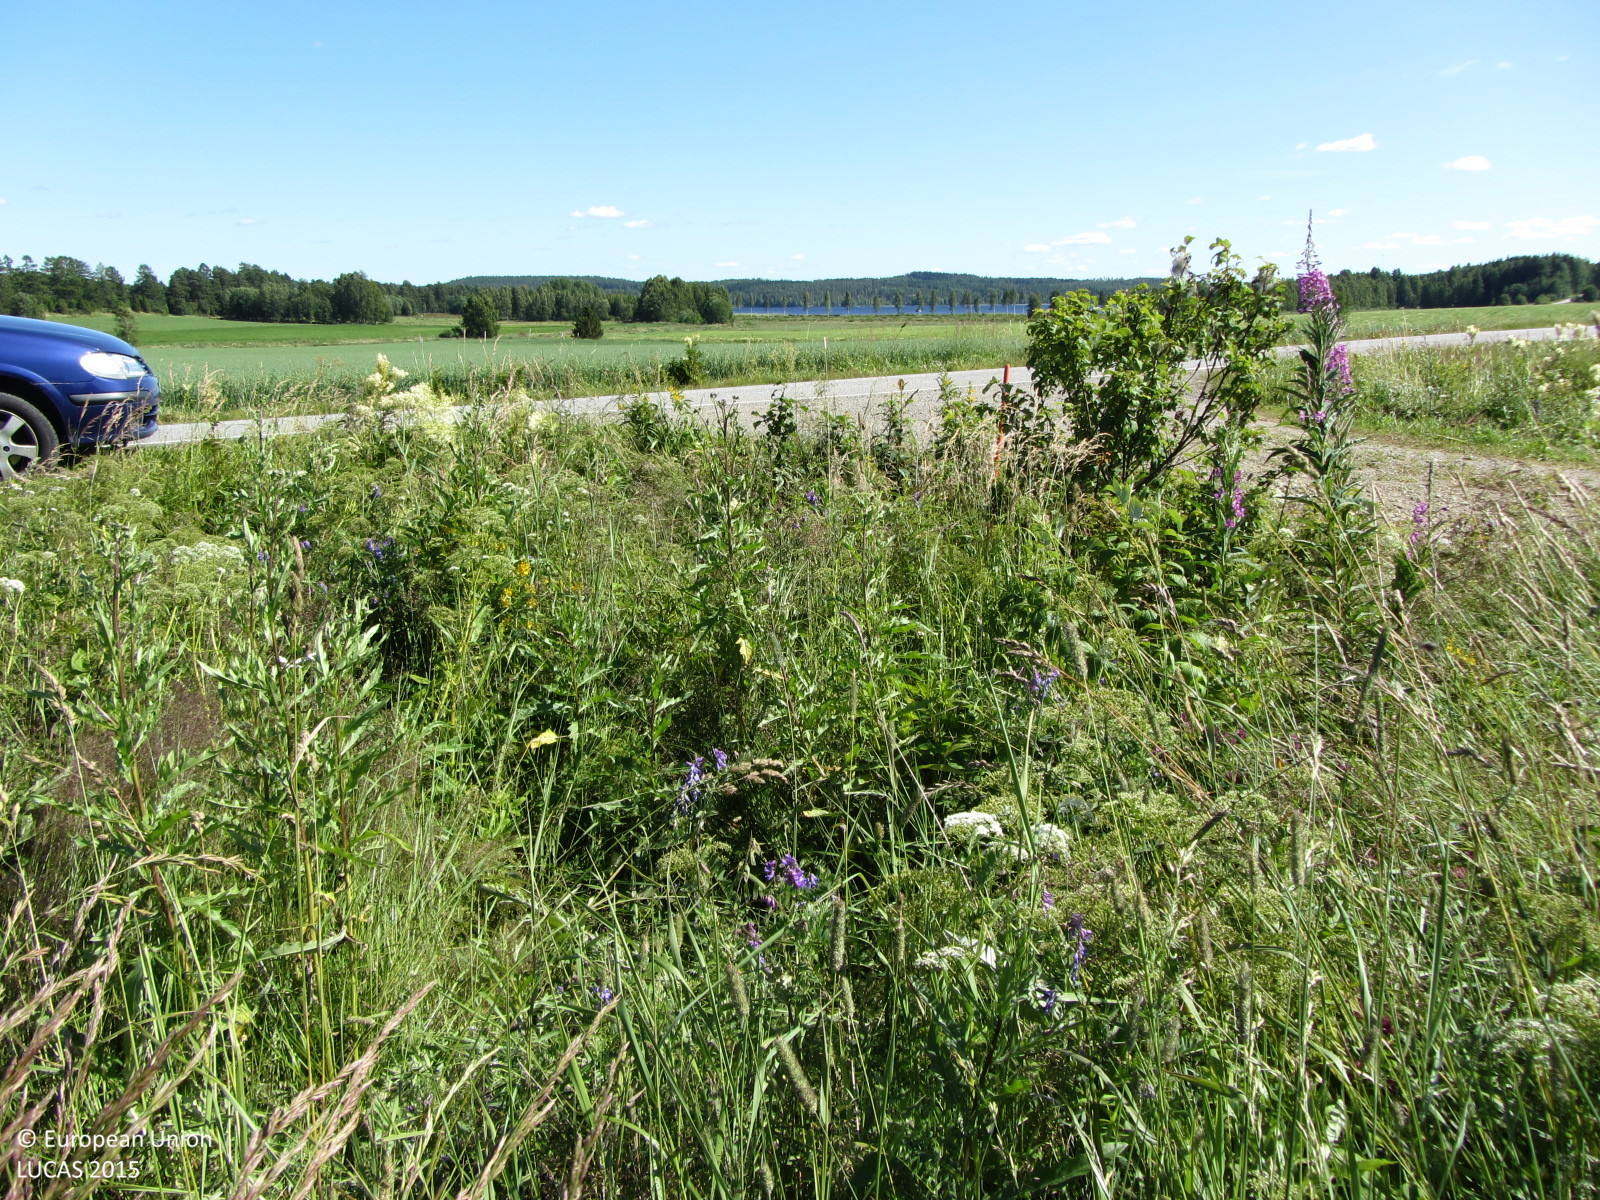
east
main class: Cropland
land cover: Temporary grasslands
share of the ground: > 75 %
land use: Agriculture (excluding fallow land and kitchen gardens)
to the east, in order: Grass margins; Ditches and canals; Grass margins; Paved roads, cycling and walking lanes; Grass margins; Oats
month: July
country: FI
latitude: 61.3253
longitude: 25.3065
